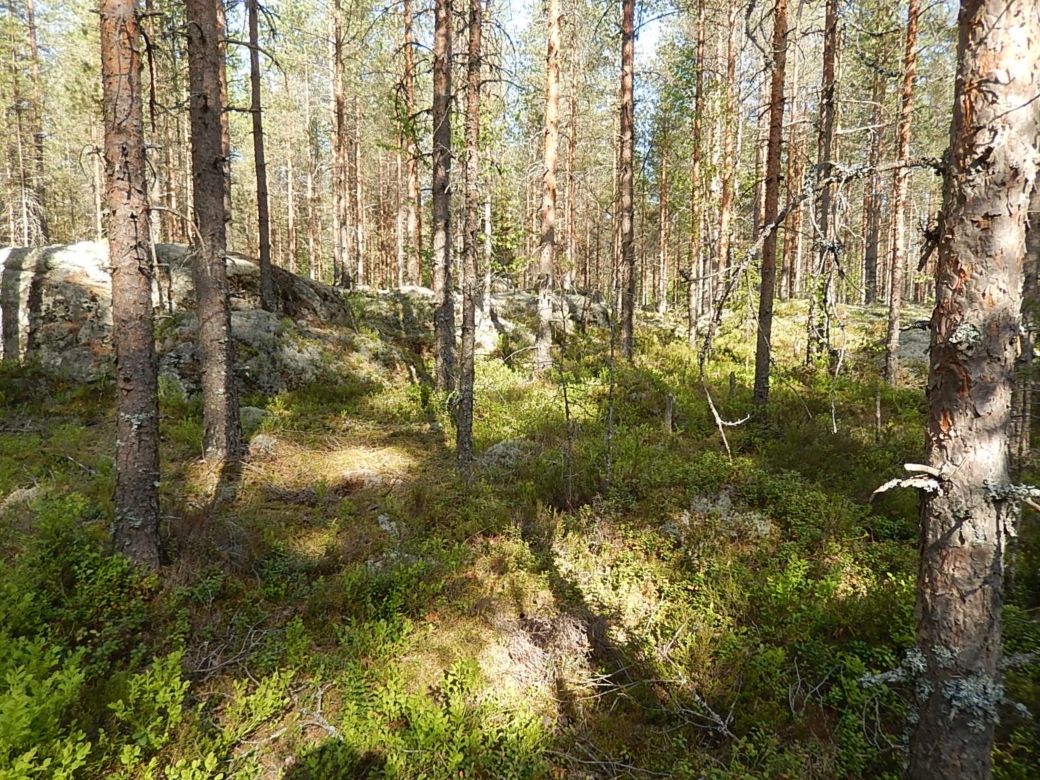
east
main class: Woodland
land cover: Pine dominated coniferous woodland
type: boreal forest
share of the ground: > 75 %
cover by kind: coniferous forest trees 75 %, shrubs 15 %, broadleaved forest trees 10 %
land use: Forestry
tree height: > 5 m
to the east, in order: Pine dominated coniferous woodland; Pine dominated mixed woodland; Ditches and canals; Pine dominated mixed woodland; Ditches and canals; Pine dominated coniferous woodland; Ditches and canals; Pine dominated mixed woodland; Ditches and canals; Pine dominated mixed woodland
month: June
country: FI
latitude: 61.9050
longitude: 22.2968
